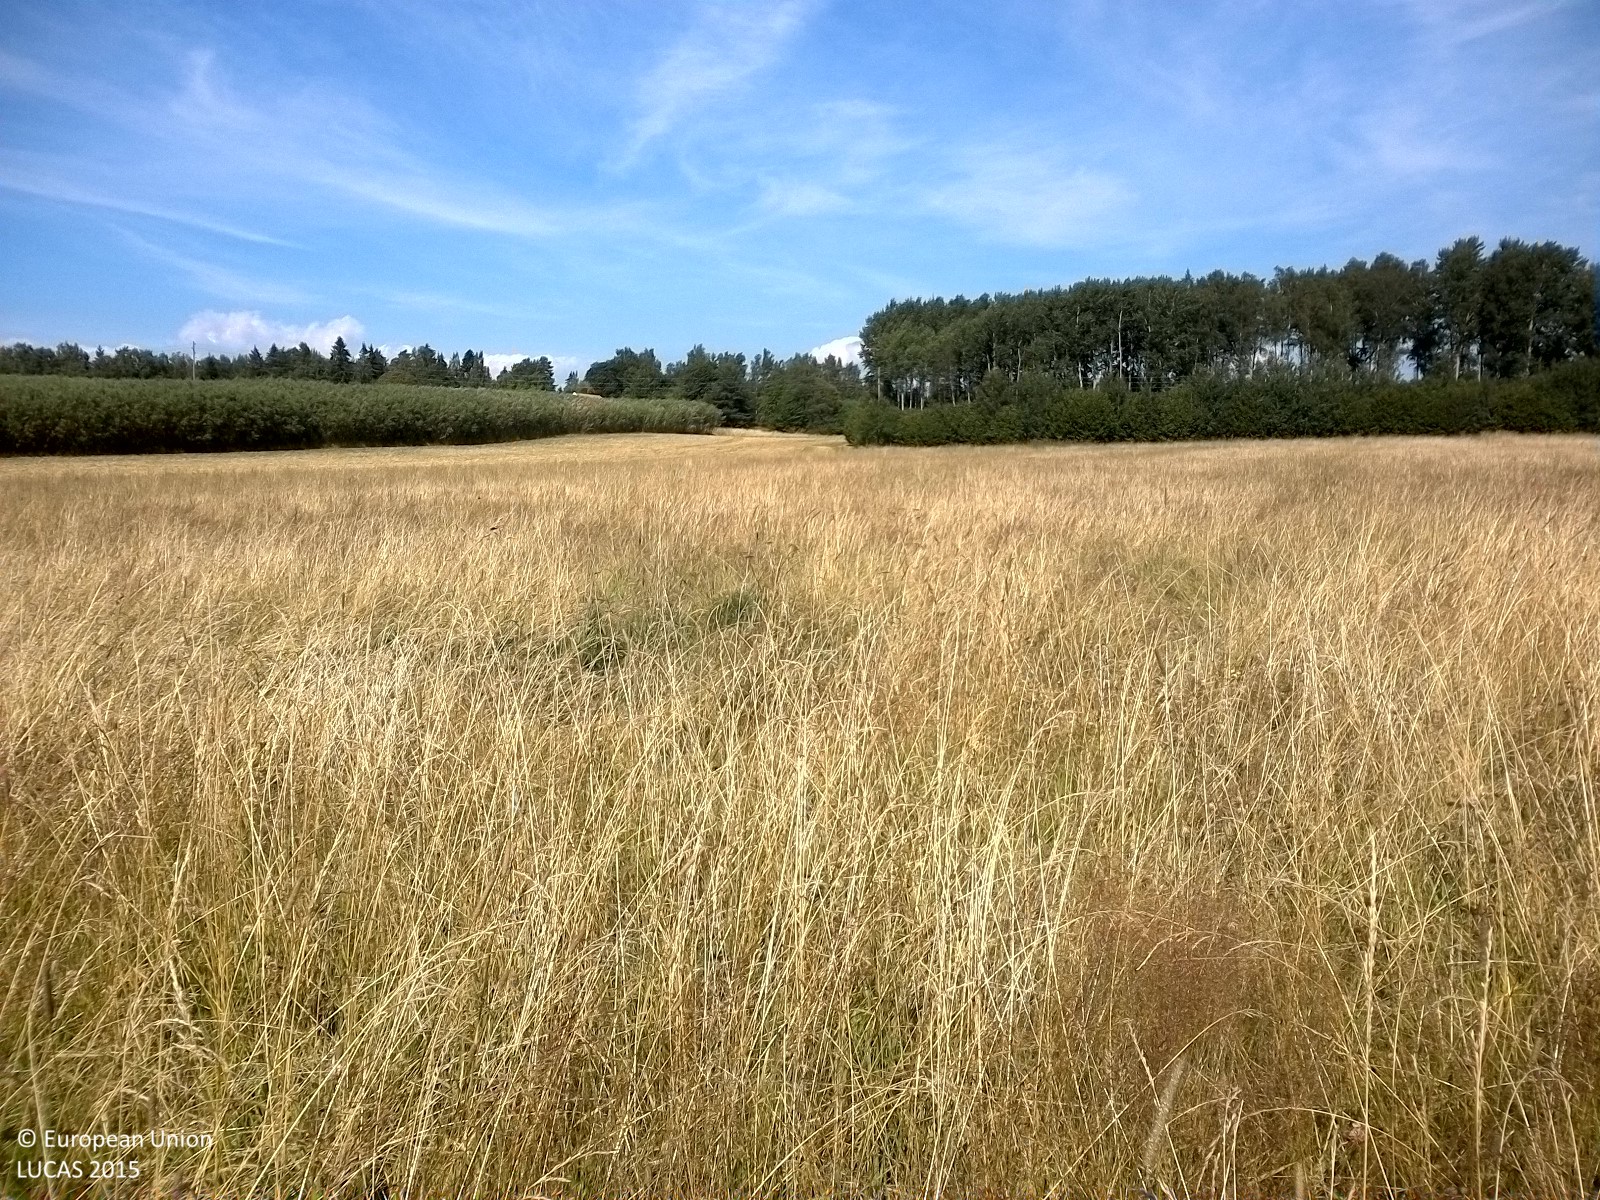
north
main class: Grassland
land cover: Grassland without tree/shrub cover
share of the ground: > 75 %
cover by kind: herbaceous plants 100 %
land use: Agriculture (excluding fallow land and kitchen gardens)
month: August
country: SE
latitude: 58.7221
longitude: 14.9837
